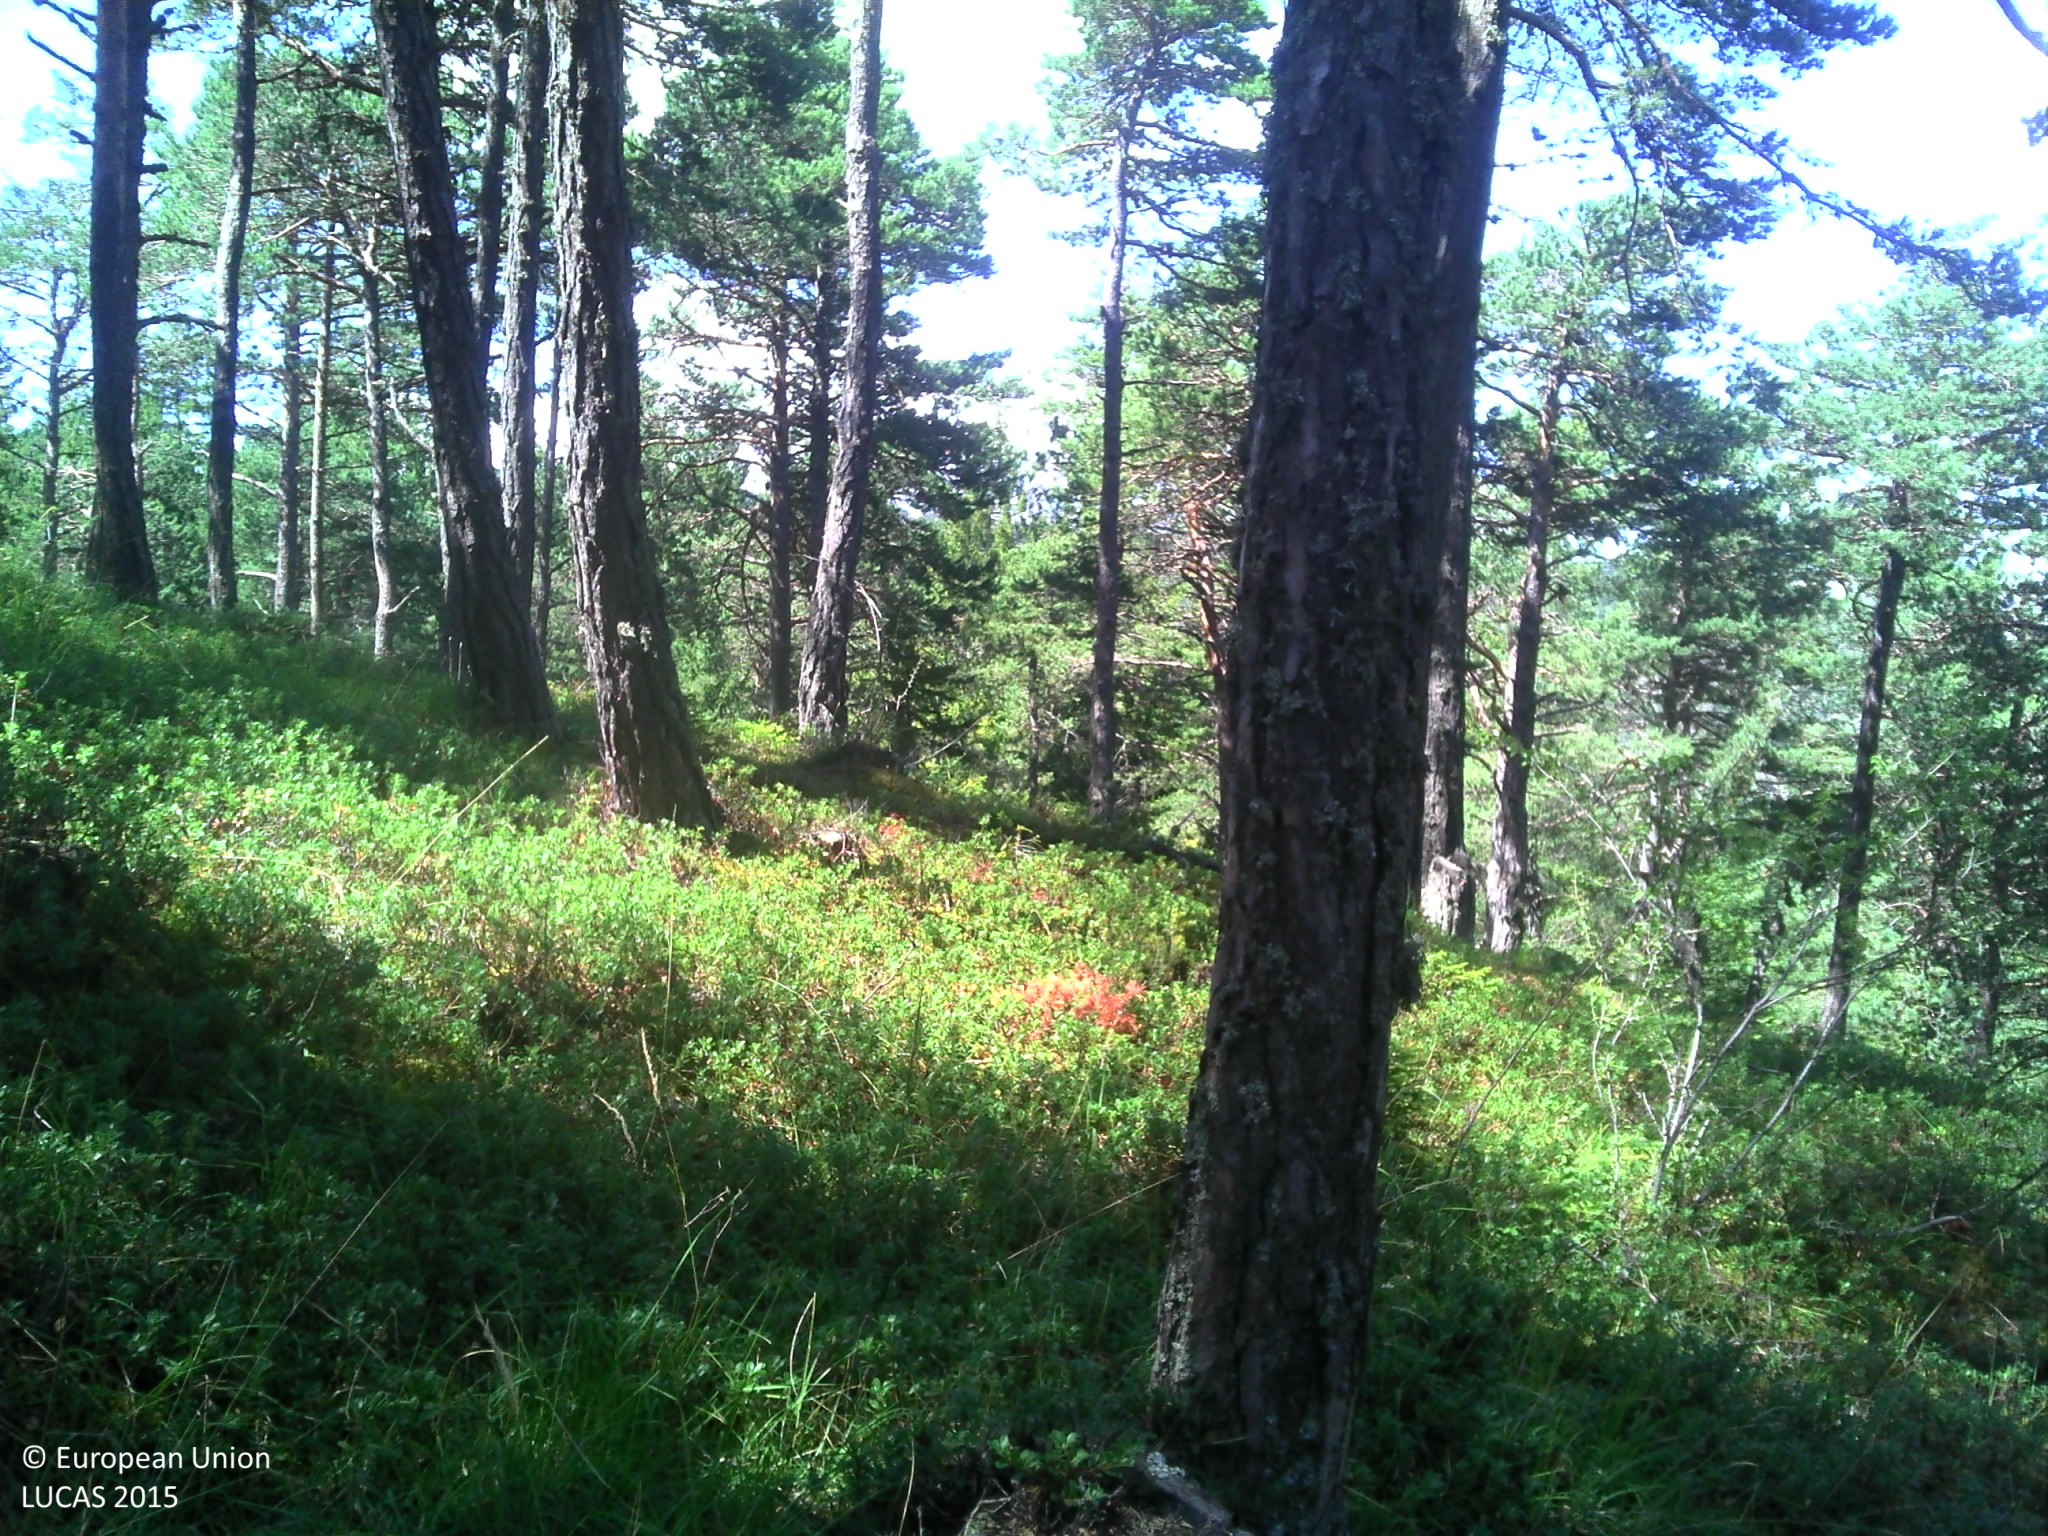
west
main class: Woodland
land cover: Pine dominated coniferous woodland
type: alpine coniferous forest
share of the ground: 50 - 75 %
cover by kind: coniferous forest trees 65 %, lichens and mosses 15 %, shrubs 10 %, herbaceous plants 10 %
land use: Forestry
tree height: > 5 m
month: August
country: FR
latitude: 44.3570
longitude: 6.3057
